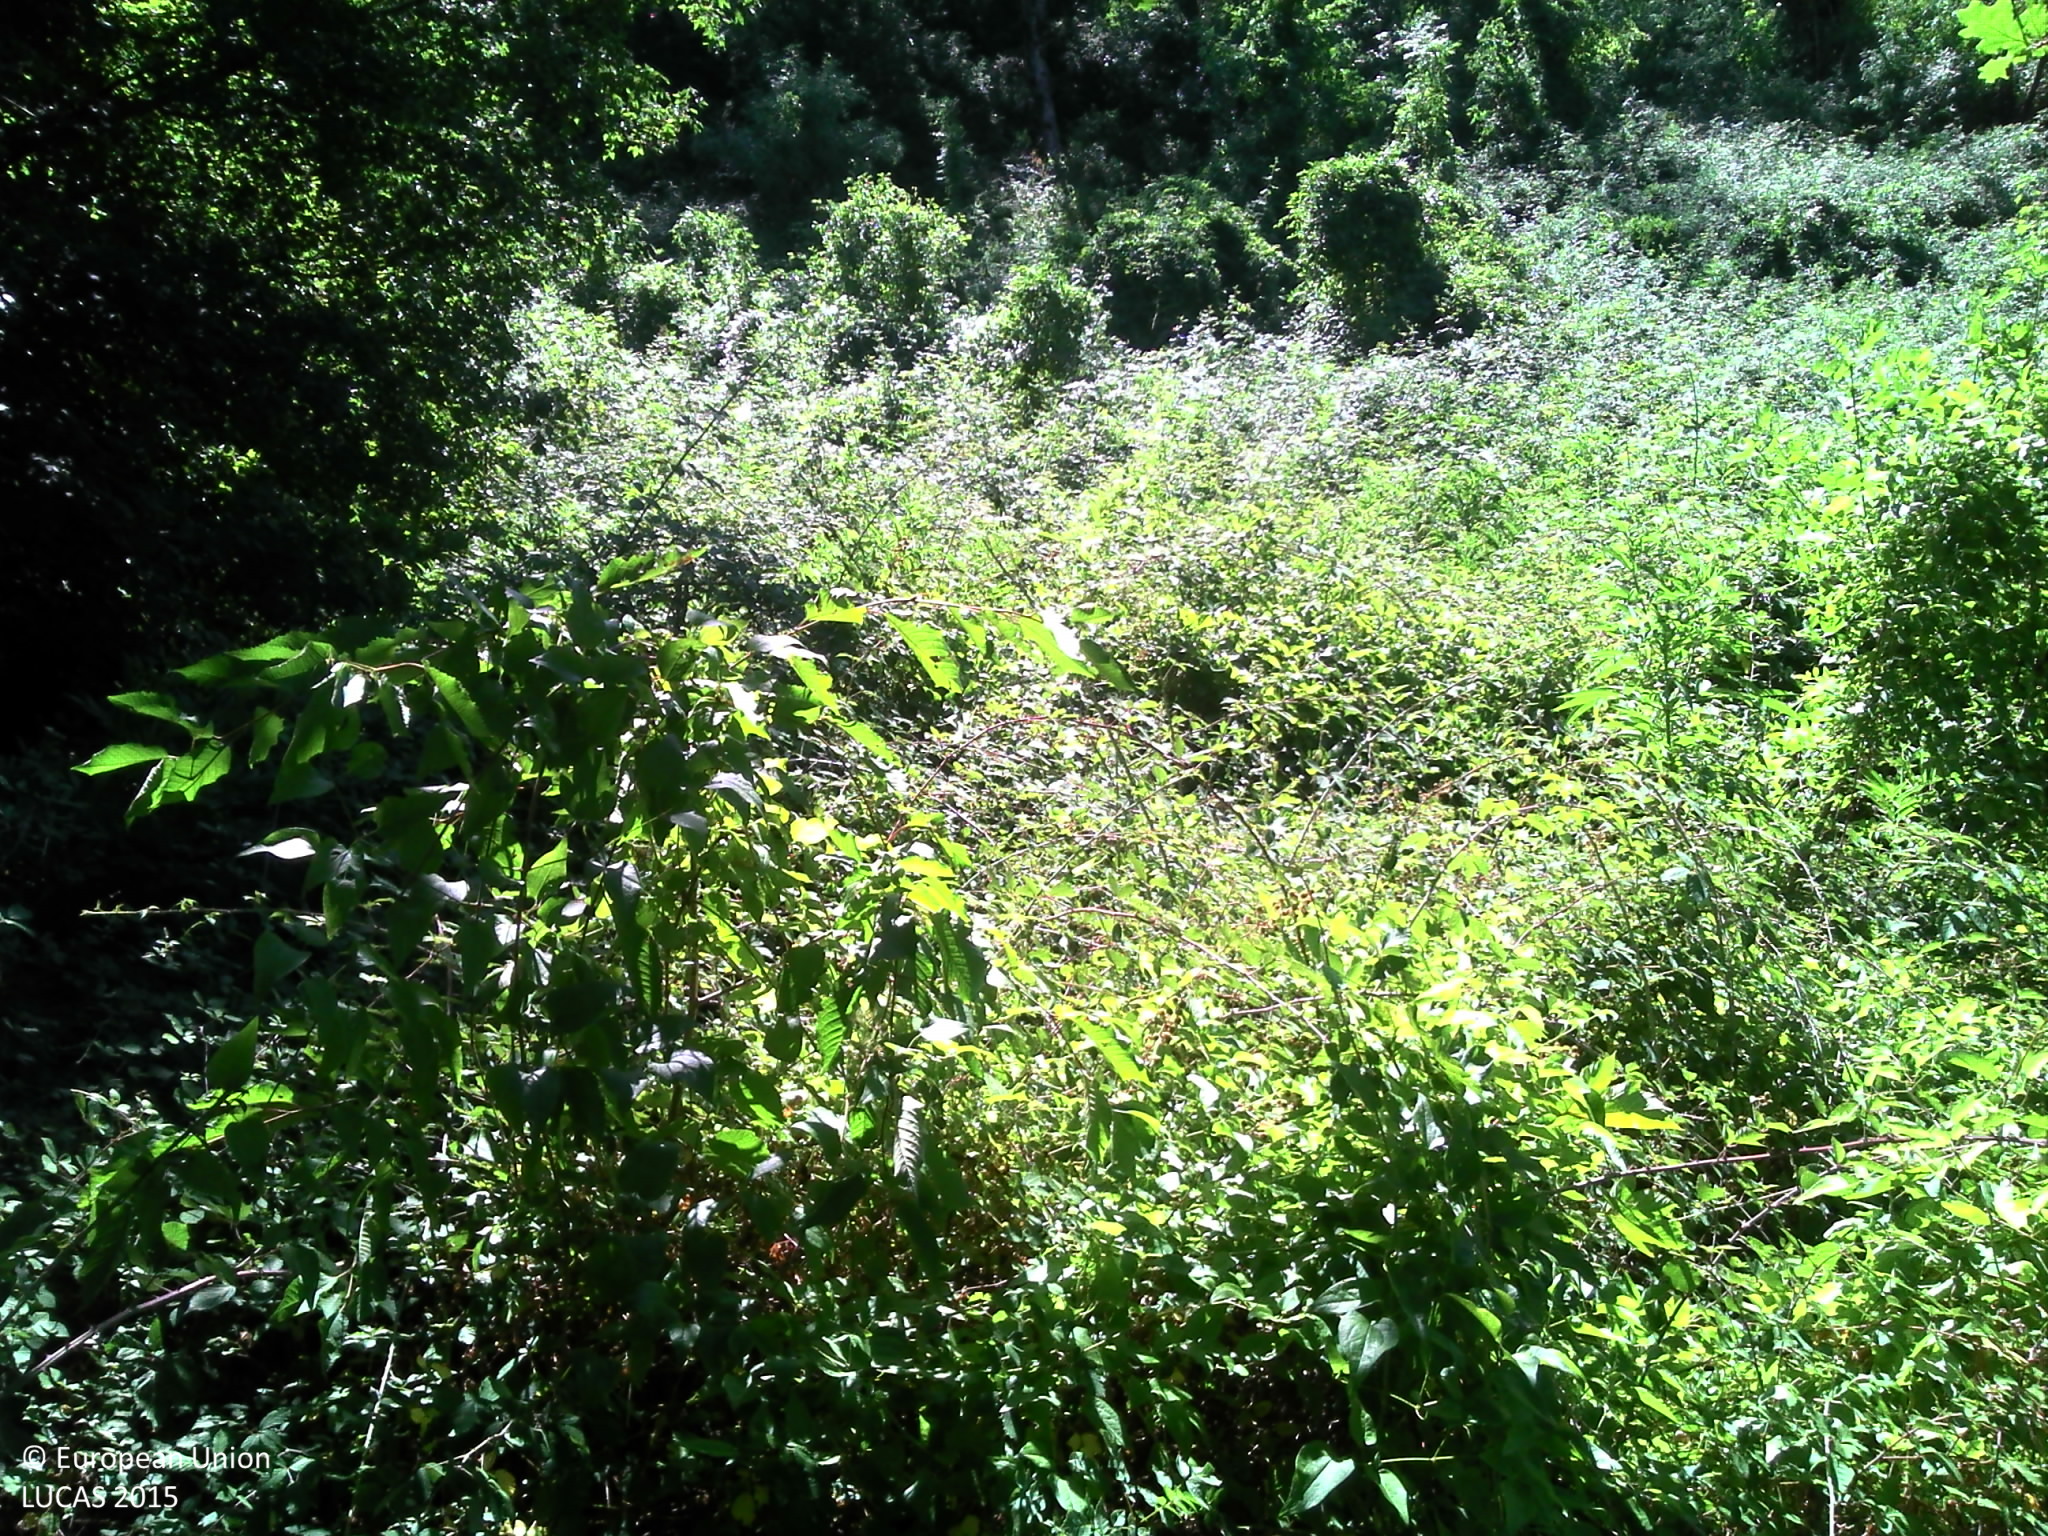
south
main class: Woodland
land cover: Broadleaved woodland
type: broadleaved evergreen forest
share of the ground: > 75 %
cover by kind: broadleaved forest trees 90 %, herbaceous plants 10 %
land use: Semi-natural and natural areas not in use
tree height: > 5 m
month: July
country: FR
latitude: 44.6988
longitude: 4.6175
